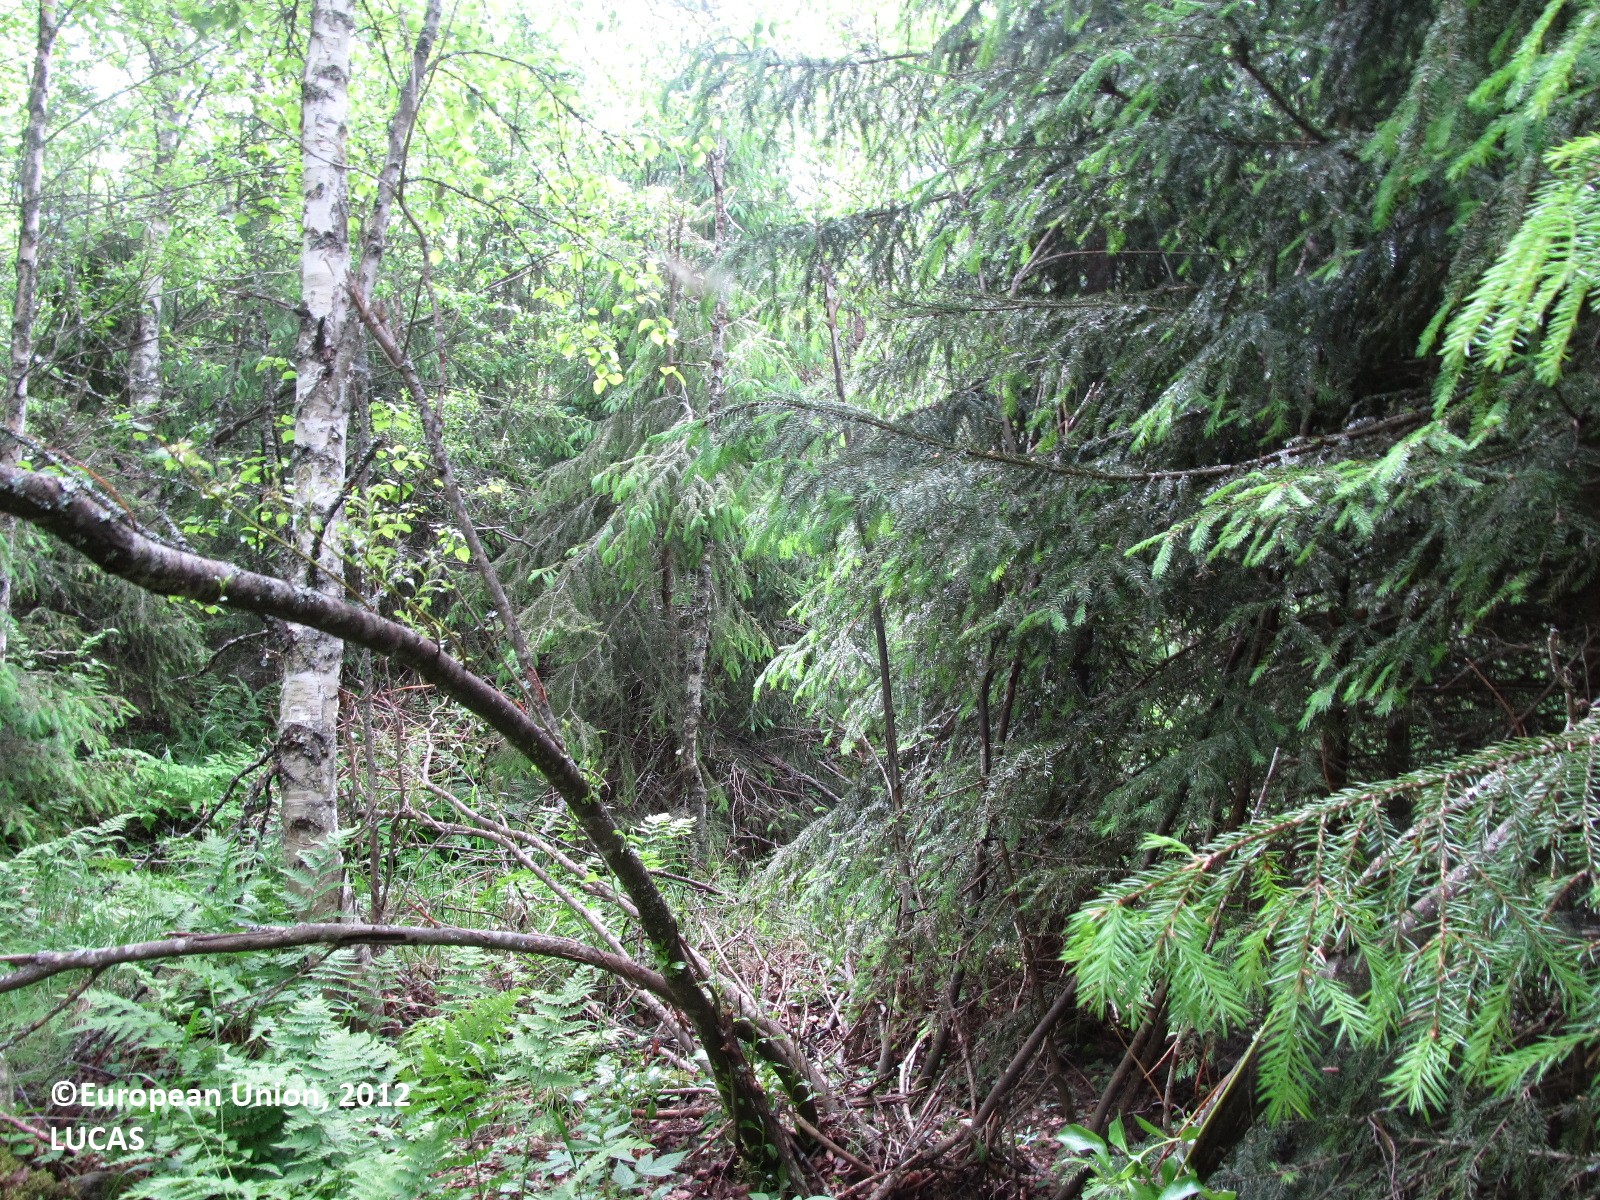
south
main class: Woodland
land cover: Spruce dominated mixed woodland
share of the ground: 50 - 75 %
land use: Forestry
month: June
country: FI
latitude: 63.2407
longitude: 27.7040
